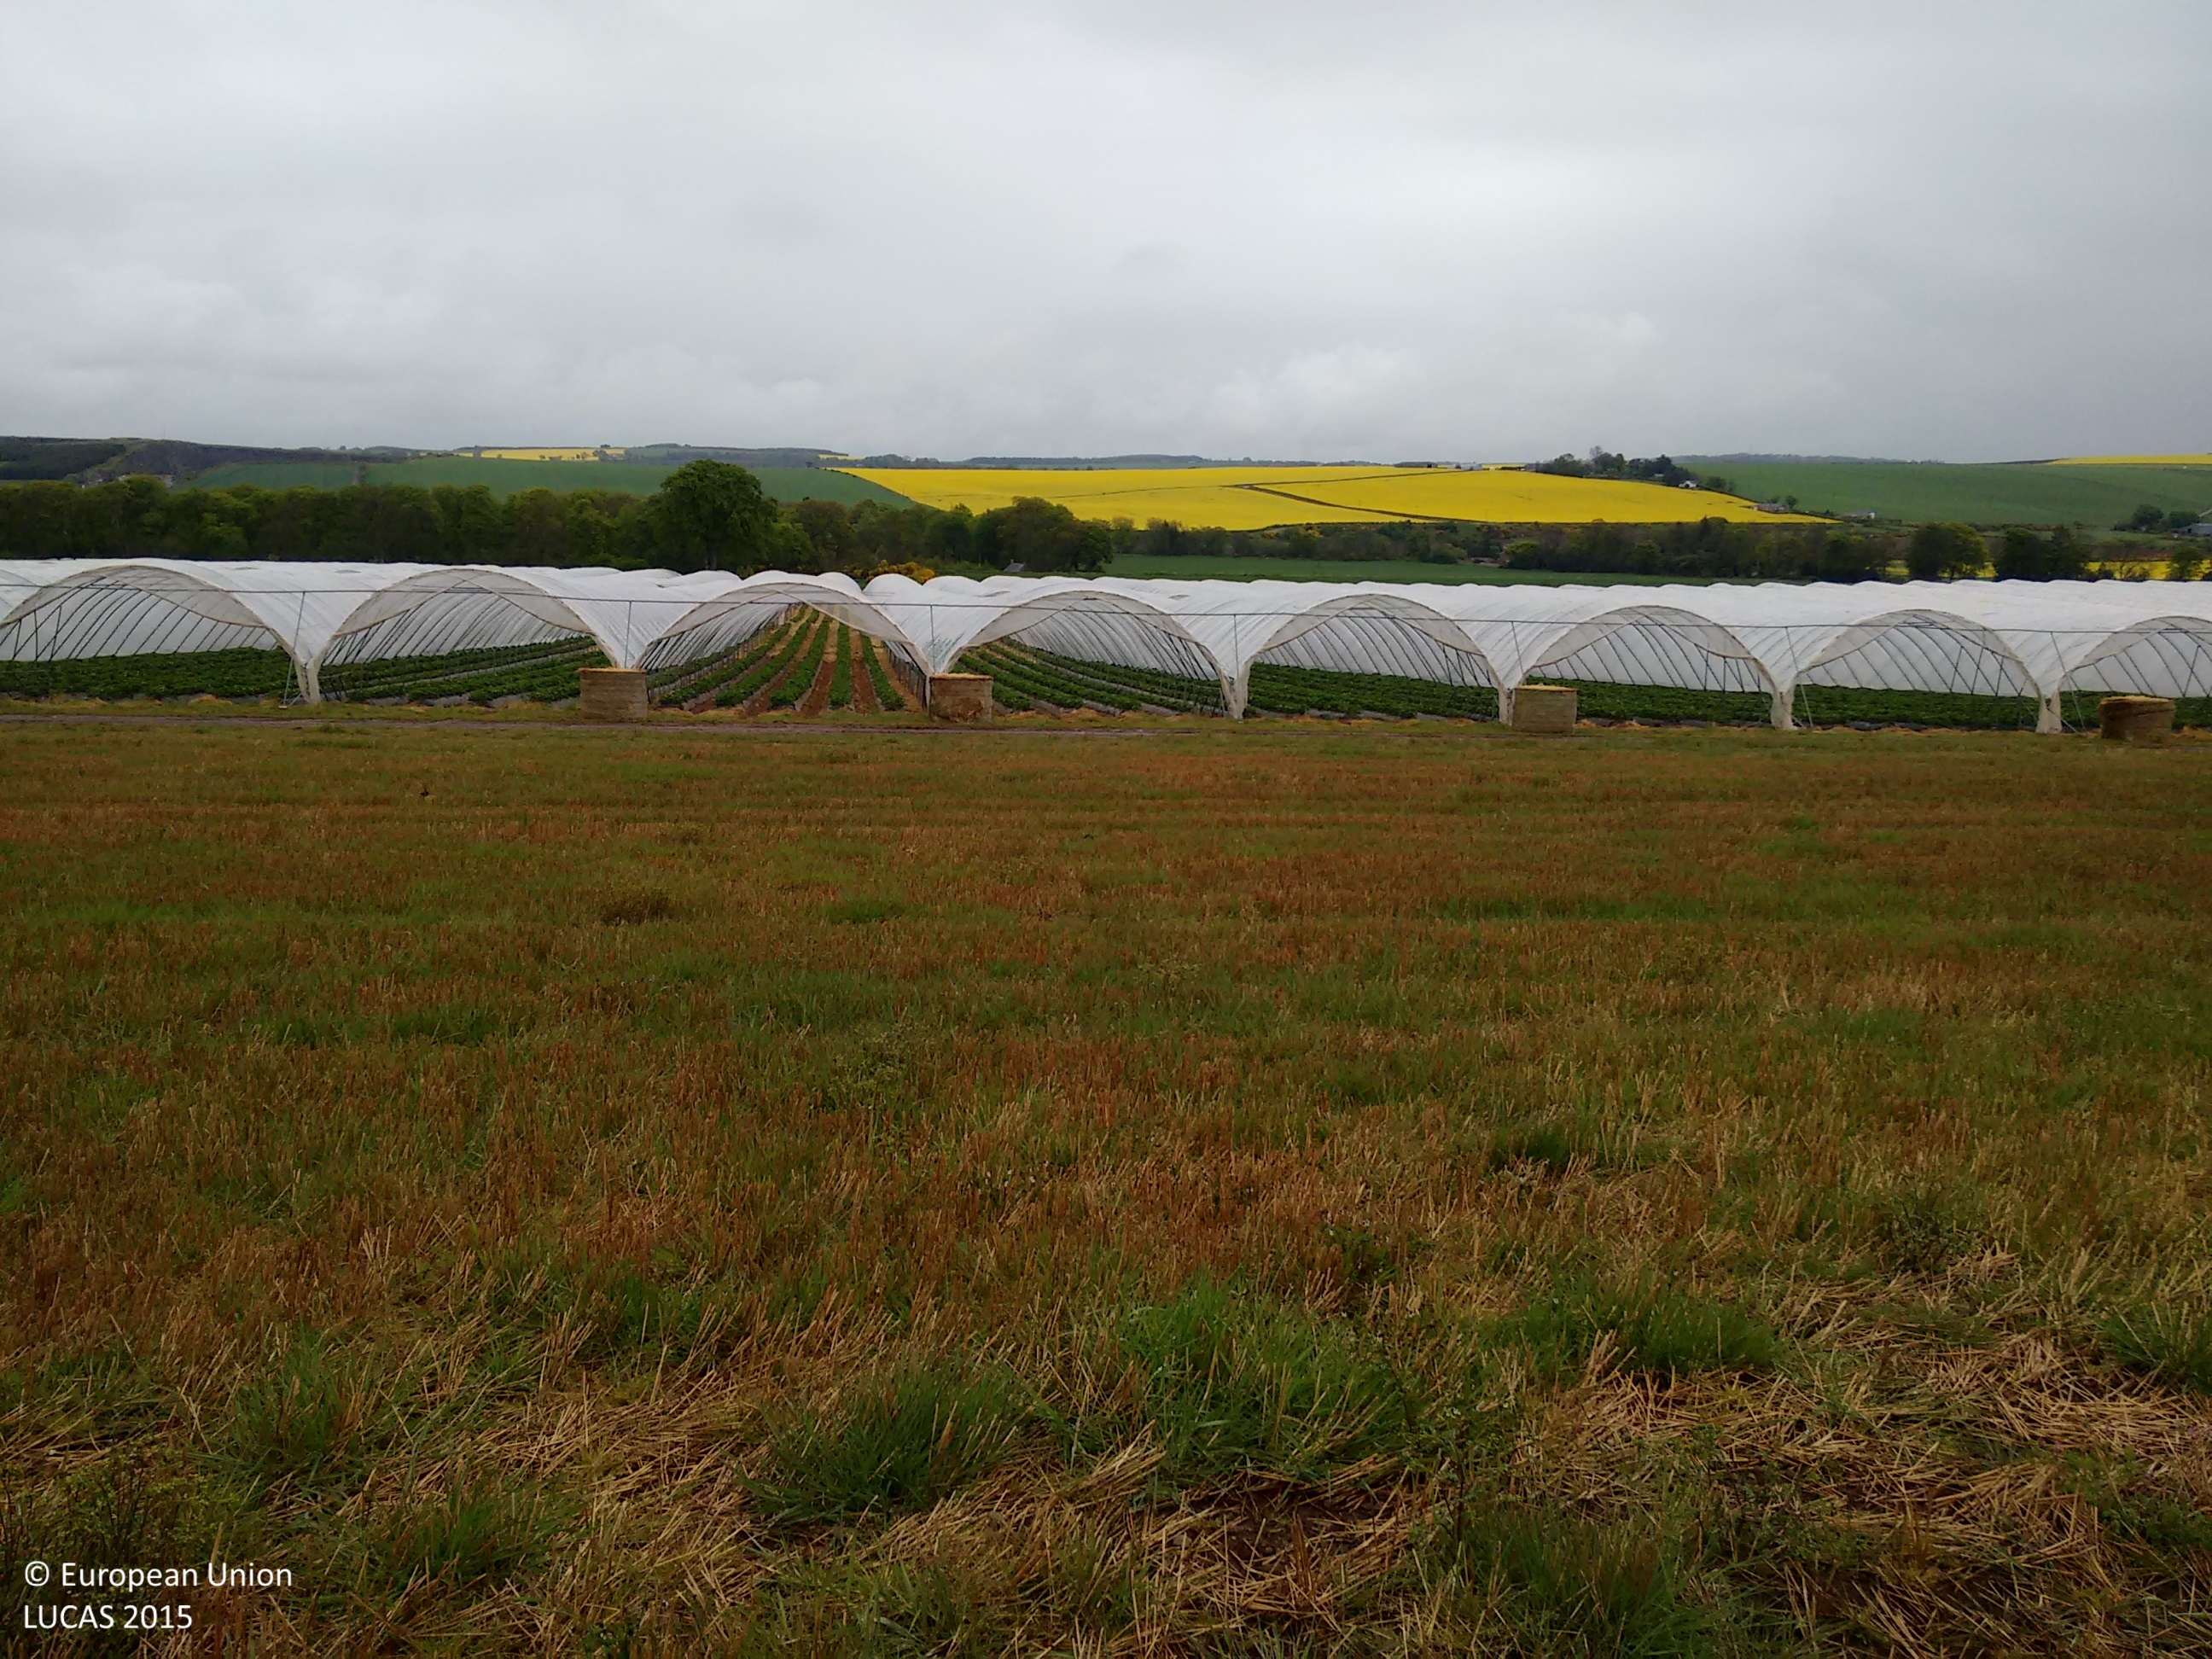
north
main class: Grassland
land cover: Grassland without tree/shrub cover
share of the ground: > 75 %
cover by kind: herbaceous plants 100 %
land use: Agriculture (excluding fallow land and kitchen gardens)
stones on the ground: 10 - 25 %
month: May
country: GB
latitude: 56.6215
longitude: -2.5910
